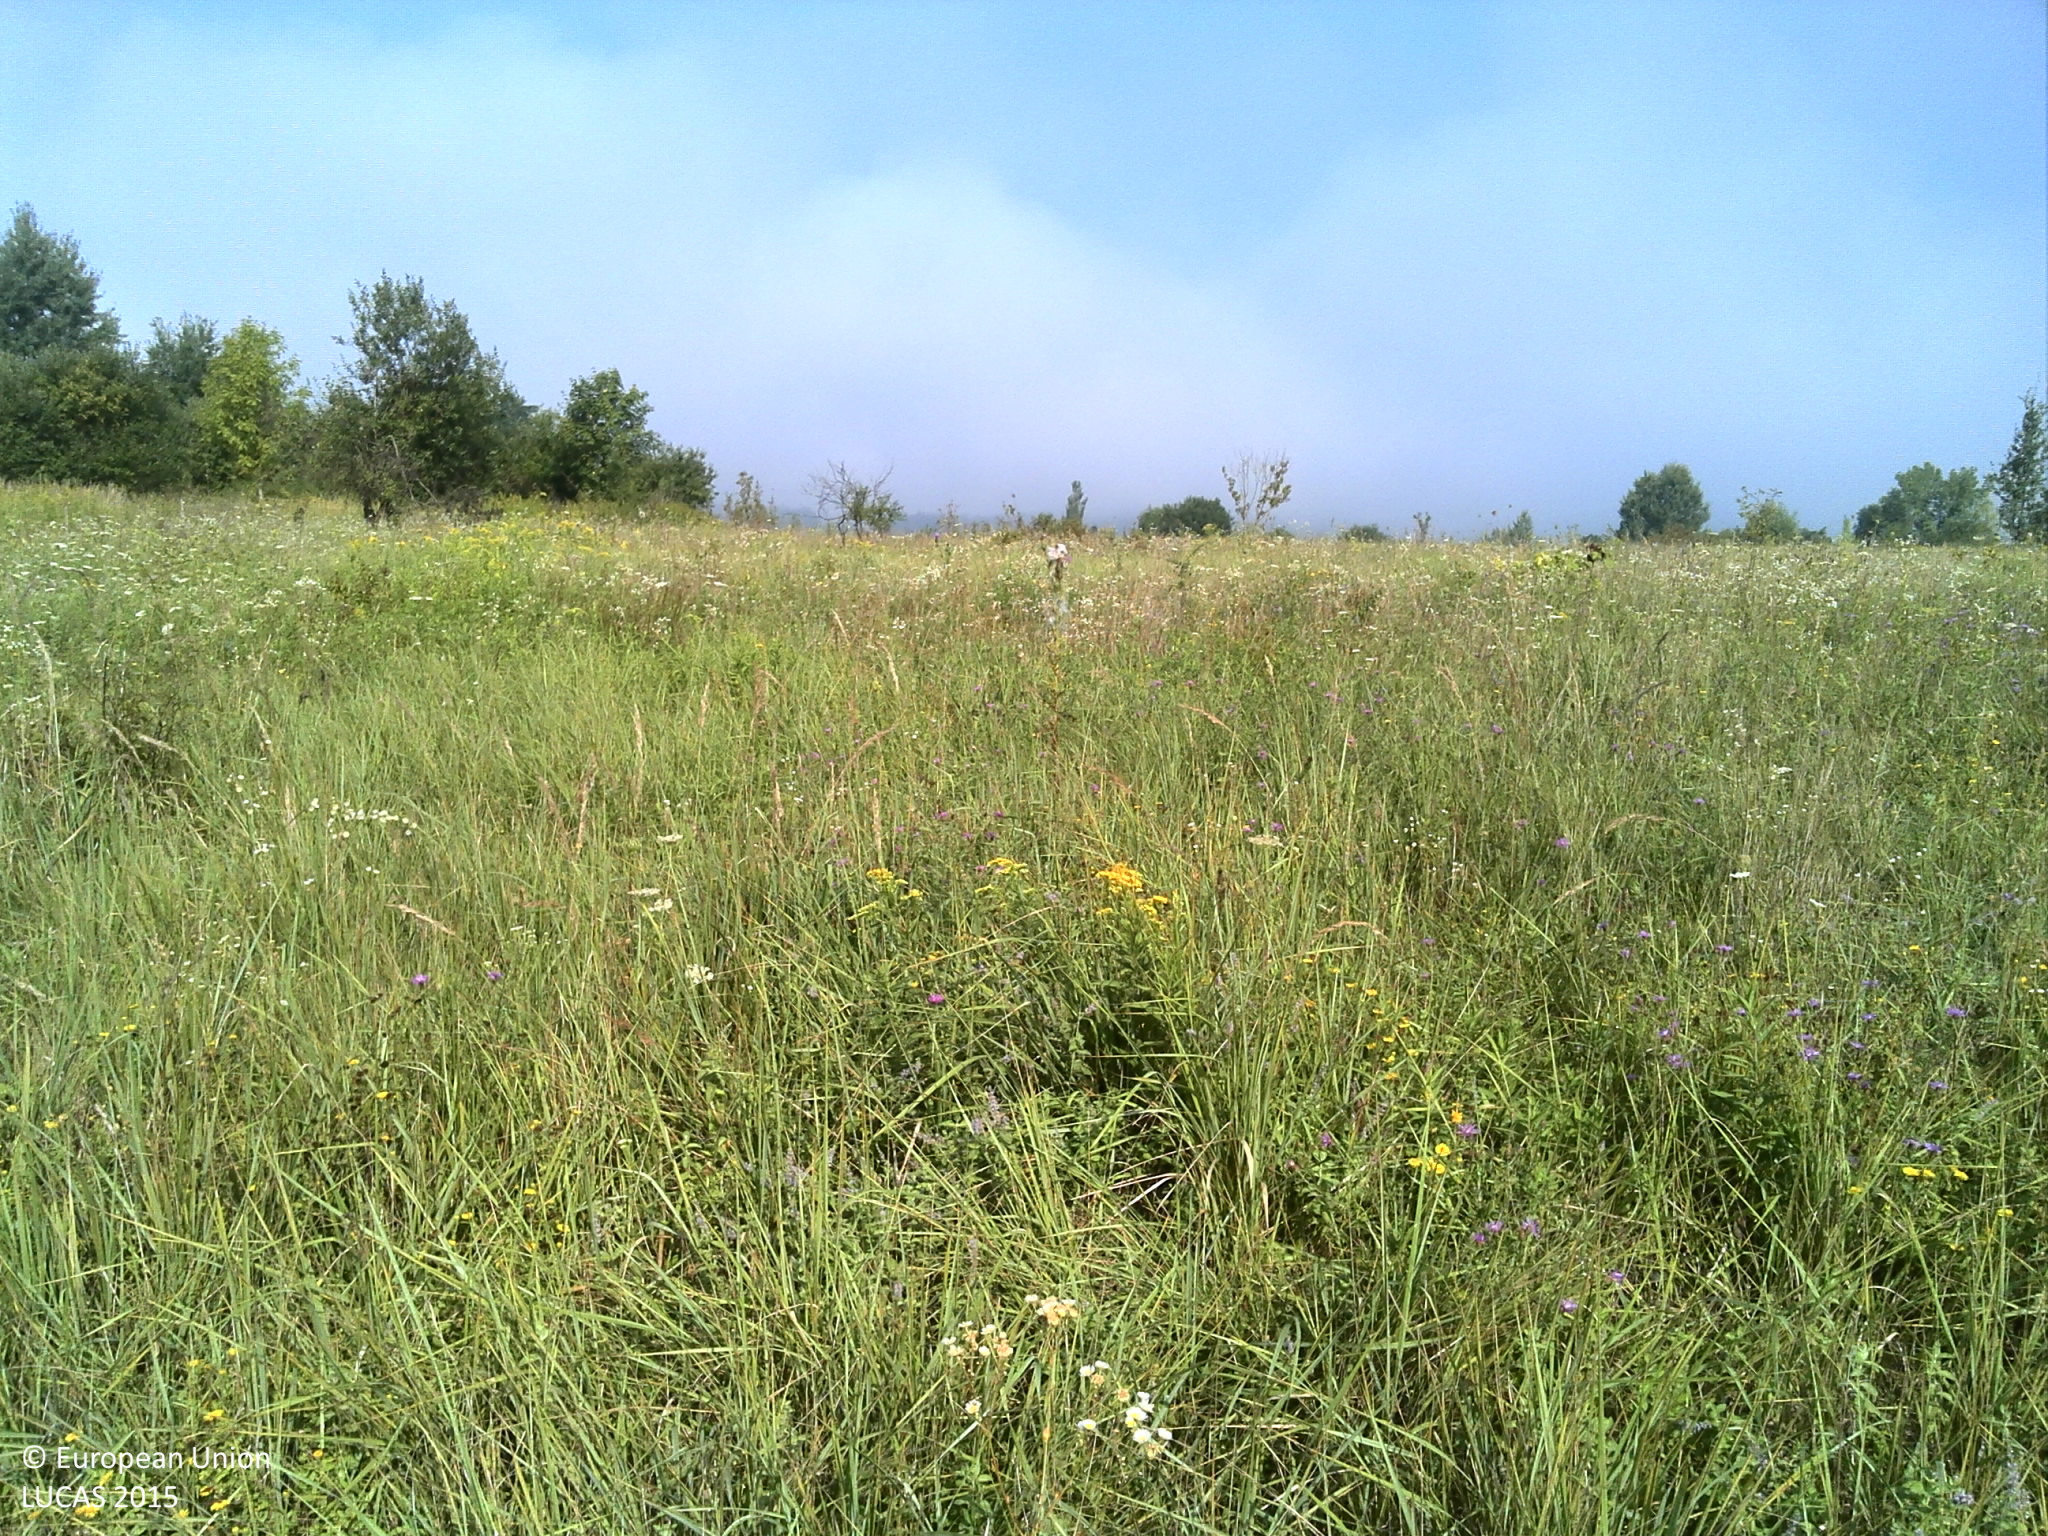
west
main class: Grassland
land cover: Spontaneously vegetated surfaces
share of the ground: > 75 %
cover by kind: herbaceous plants 100 %
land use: Semi-natural and natural areas not in use
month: August
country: HR
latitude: 45.1135
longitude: 16.3648
